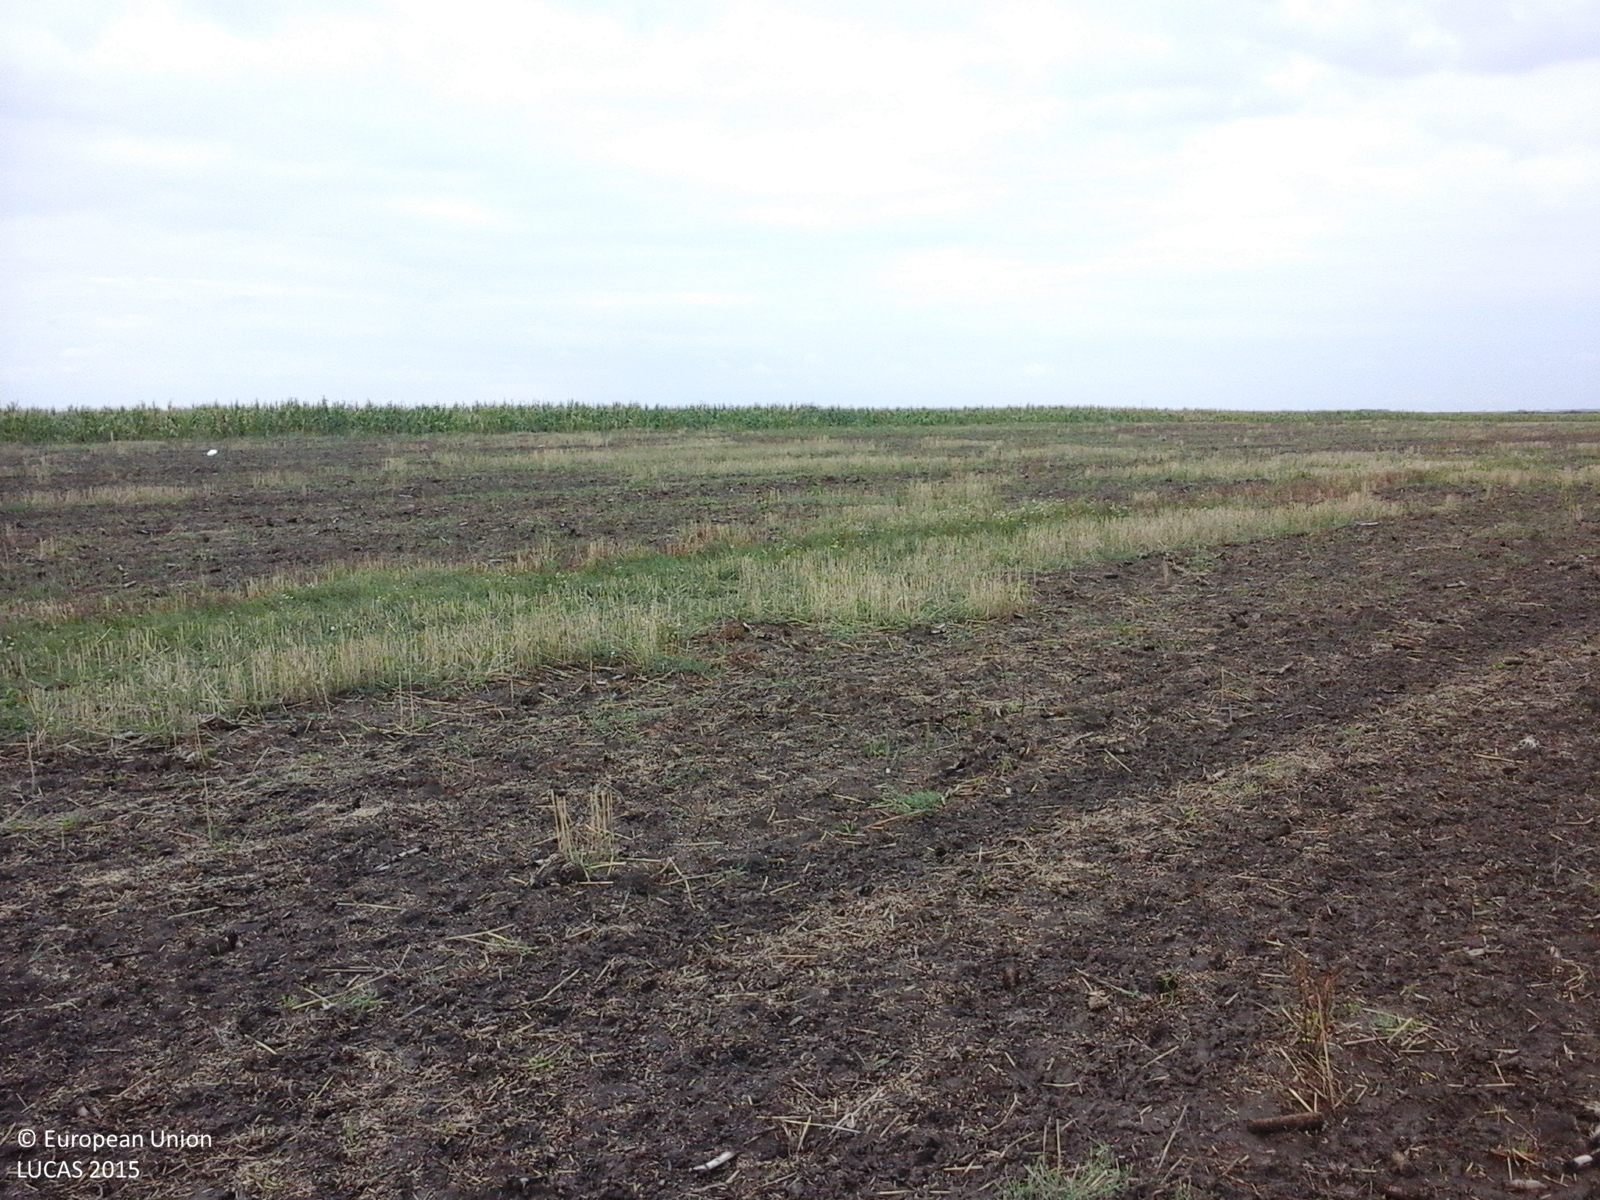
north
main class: Cropland
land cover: Common wheat
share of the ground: < 10 %
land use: Agriculture (excluding fallow land and kitchen gardens)
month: August
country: RO
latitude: 45.5677
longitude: 21.1374
